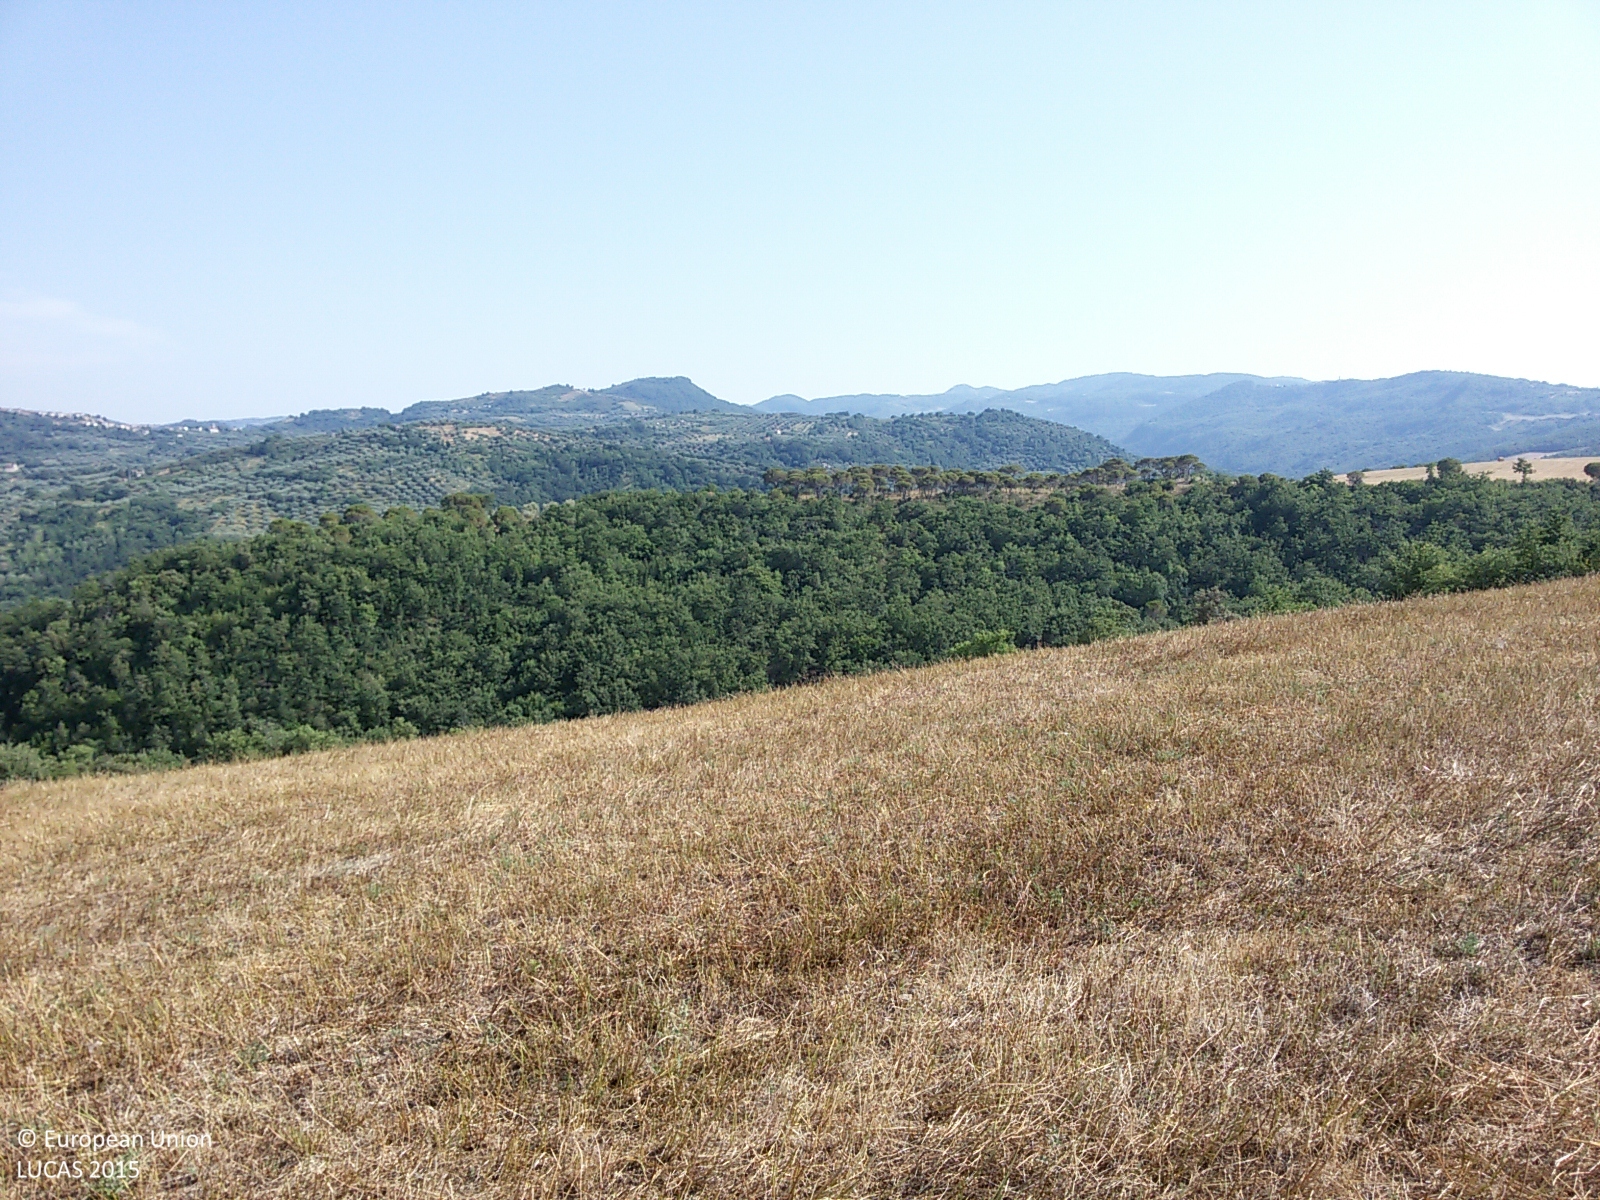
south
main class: Cropland
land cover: Temporary grasslands
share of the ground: 50 - 75 %
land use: Agriculture (excluding fallow land and kitchen gardens)
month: July
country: IT
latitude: 42.9319
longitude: 11.5024
